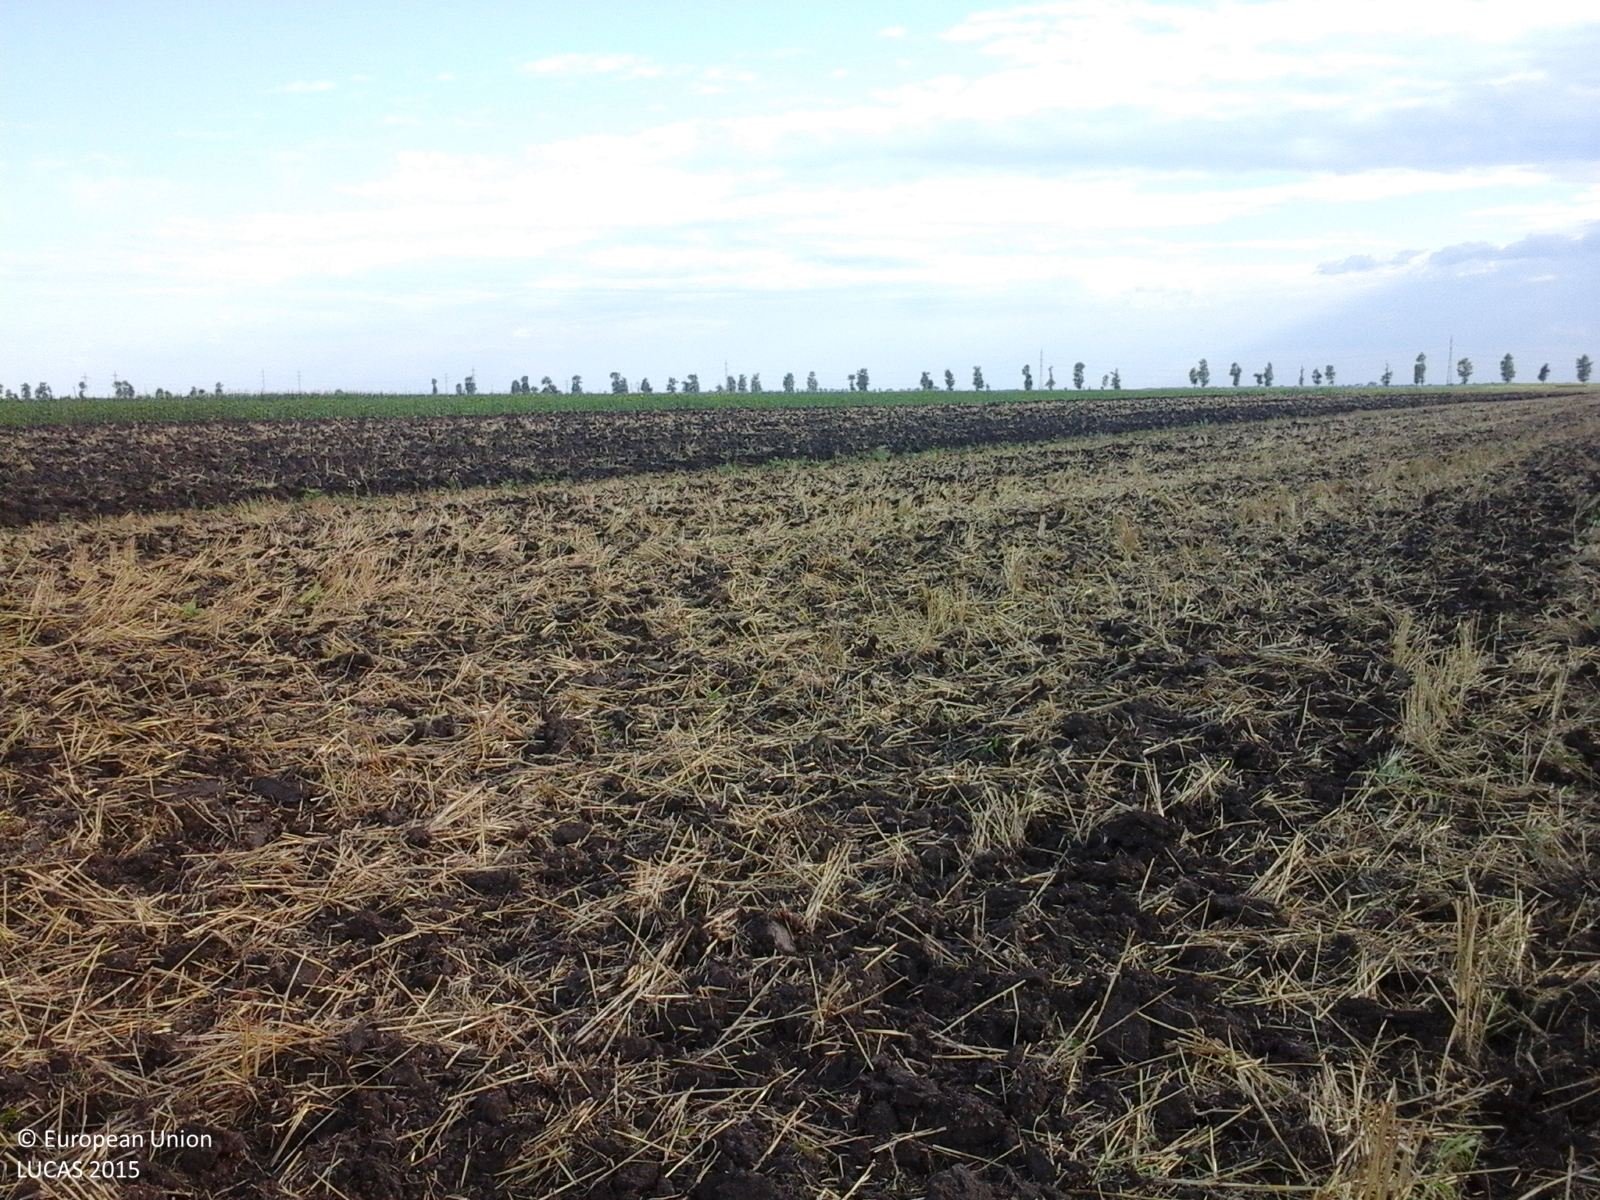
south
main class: Cropland
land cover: Common wheat
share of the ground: < 10 %
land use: Agriculture (excluding fallow land and kitchen gardens)
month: July
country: RO
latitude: 44.1803
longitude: 25.5379
